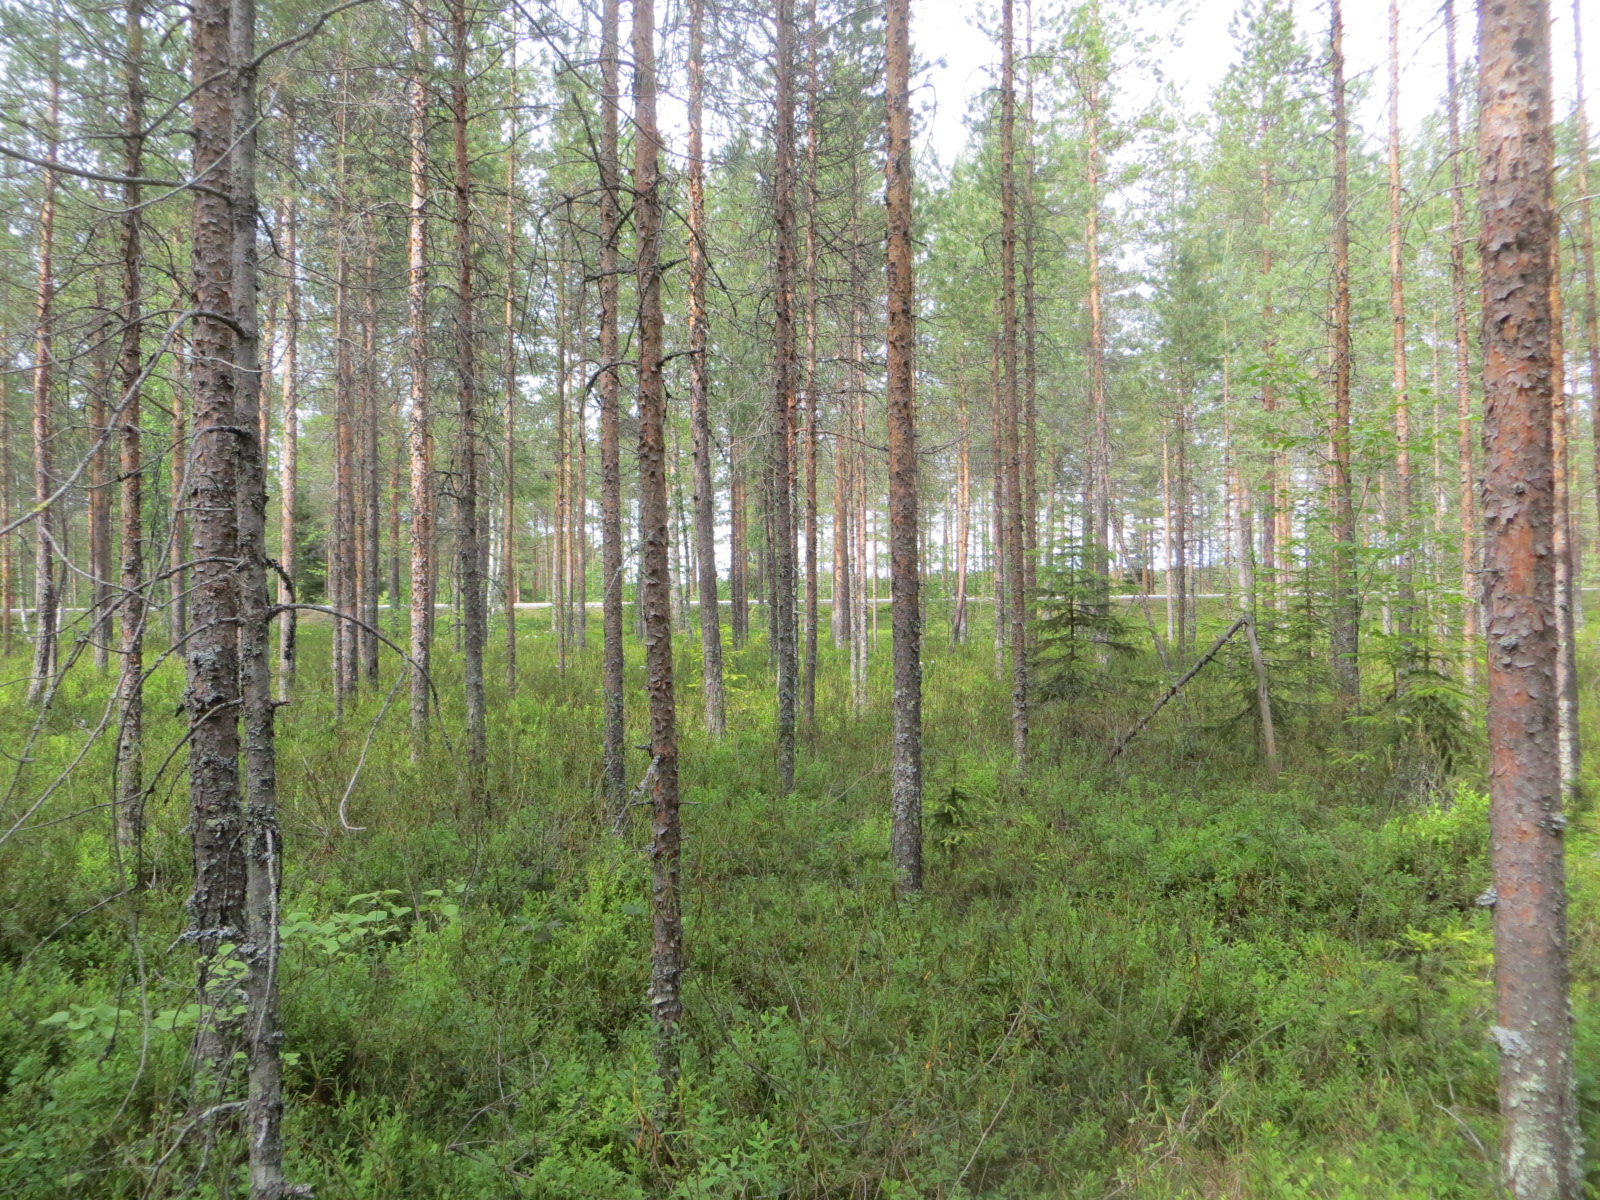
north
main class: Woodland
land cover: Pine dominated coniferous woodland
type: boreal forest
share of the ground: 50 - 75 %
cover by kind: coniferous forest trees 65 %, shrubs 30 %, broadleaved forest trees 5 %
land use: Forestry
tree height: > 5 m
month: July
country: FI
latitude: 65.3676
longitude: 25.8924
